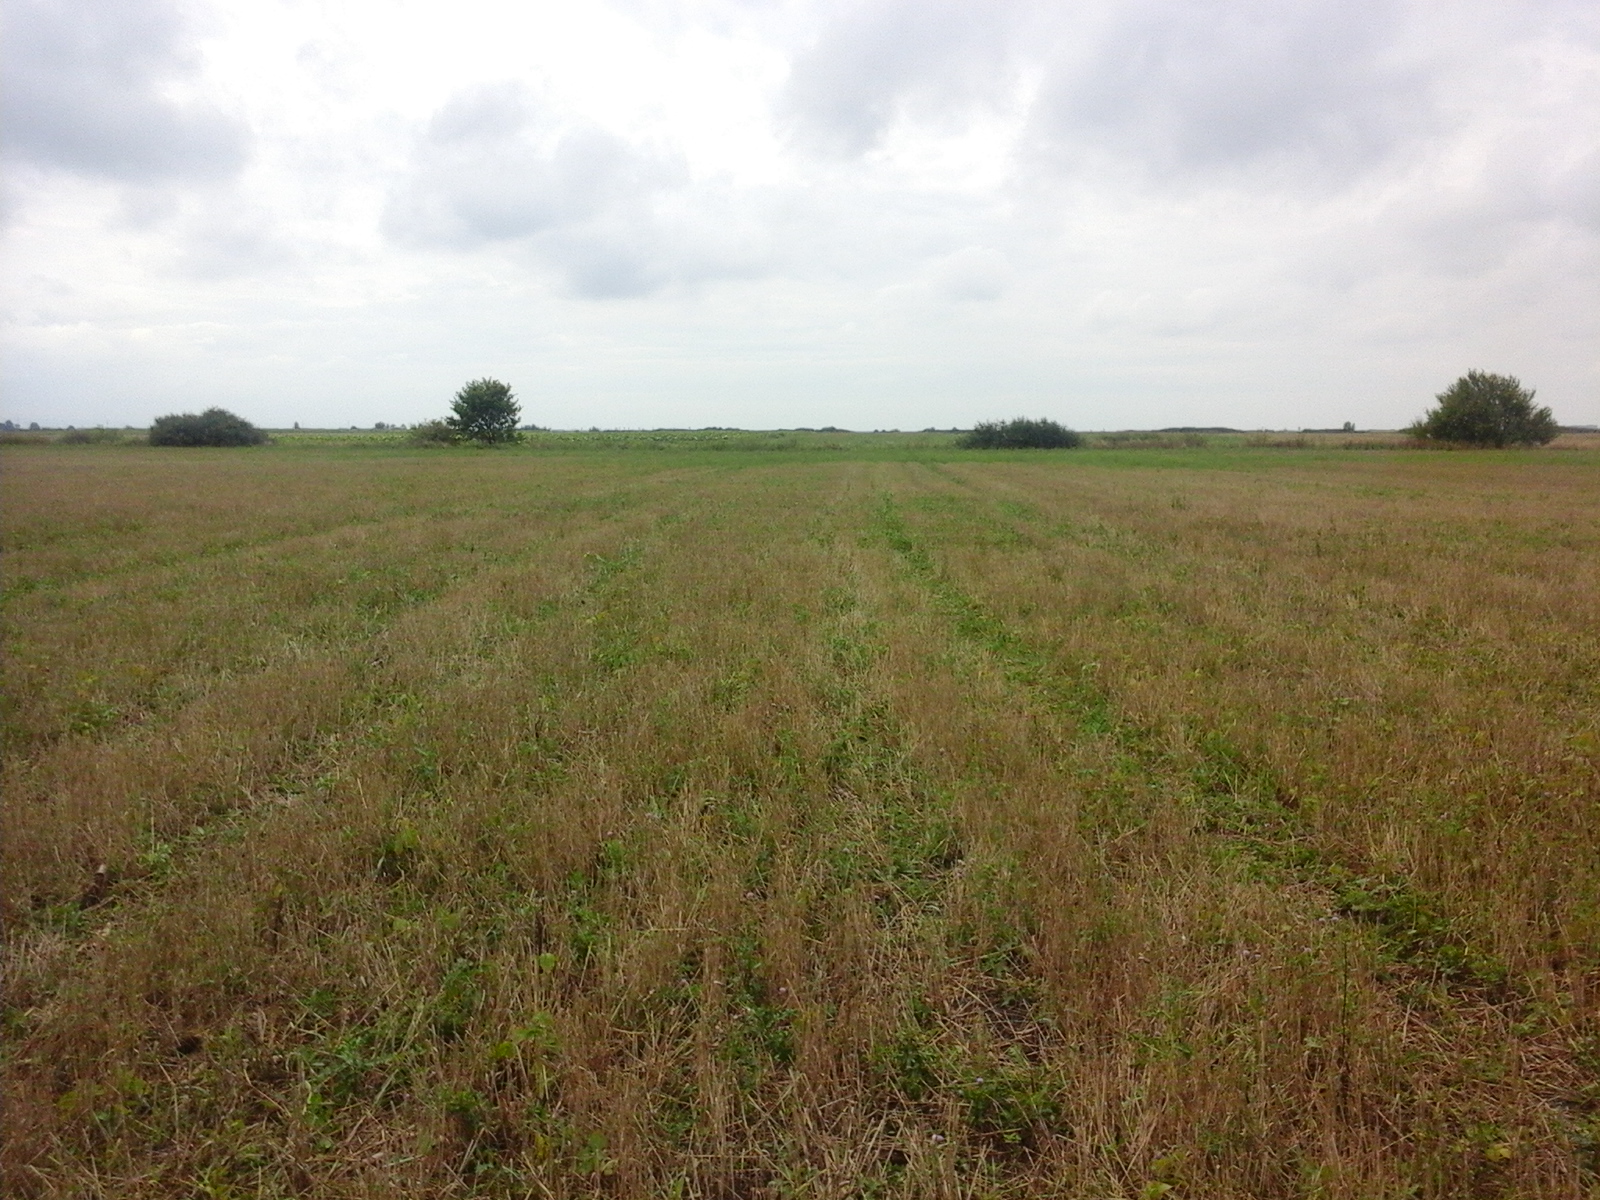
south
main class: Cropland
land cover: Common wheat
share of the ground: 50 - 75 %
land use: Agriculture (excluding fallow land and kitchen gardens)
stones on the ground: < 10 %
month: August
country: RO
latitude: 45.5816
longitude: 21.3476
